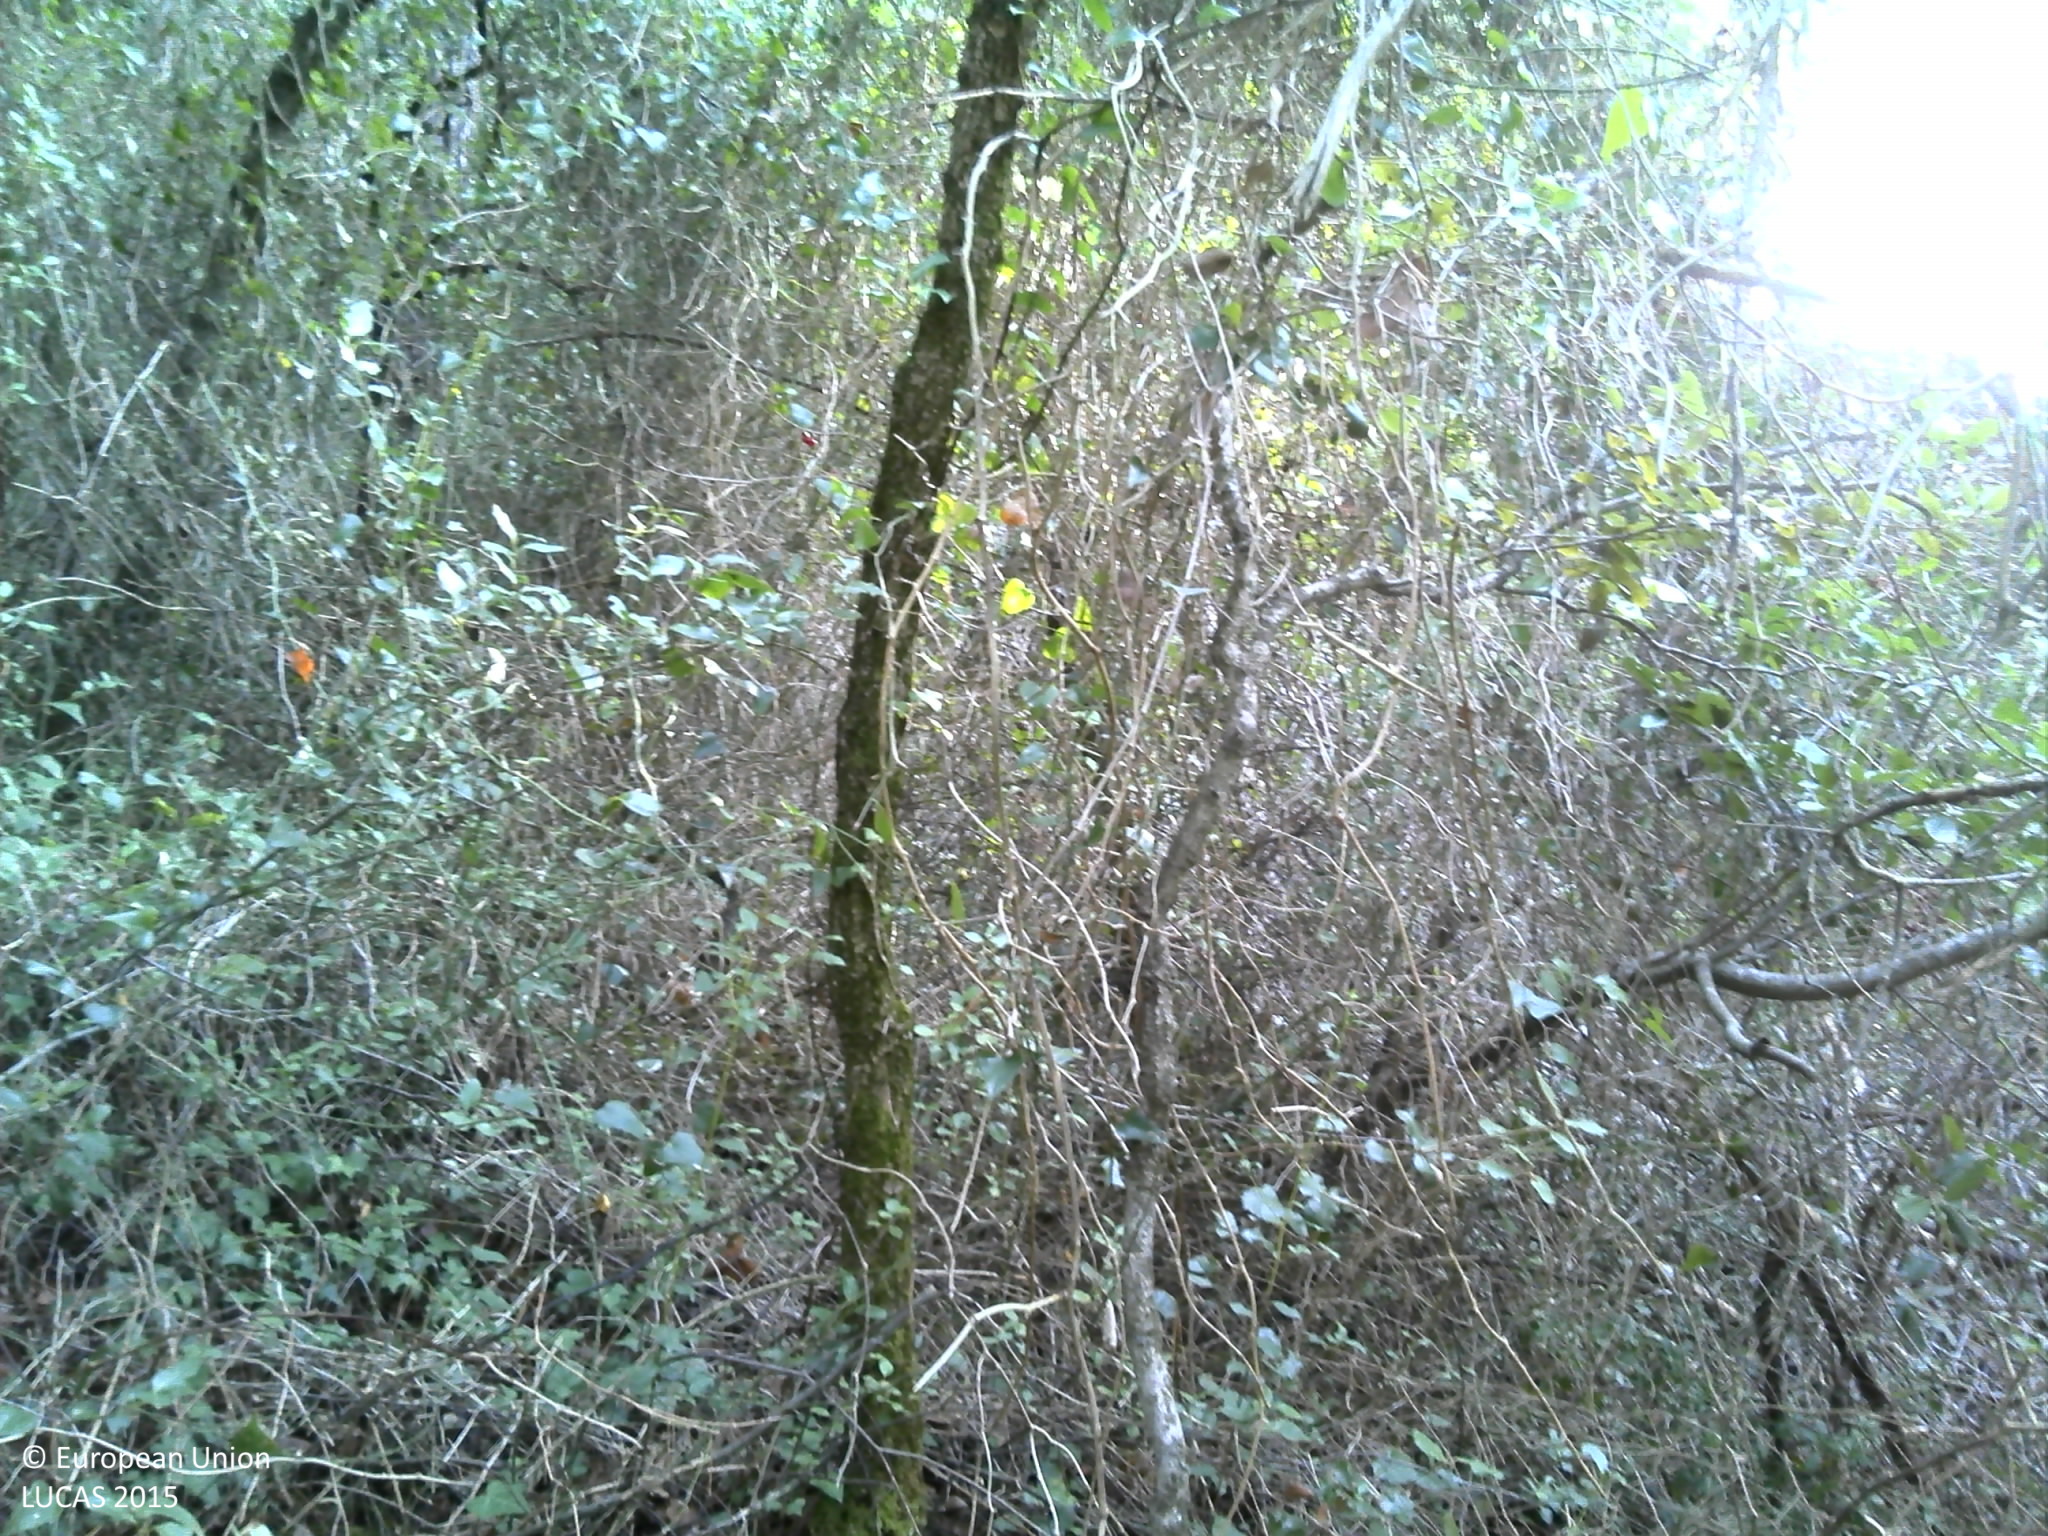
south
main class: Woodland
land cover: Pine dominated mixed woodland
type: broadleaved evergreen forest
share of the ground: > 75 %
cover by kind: broadleaved forest trees 50 %, coniferous forest trees 25 %, herbaceous plants 15 %, lichens and mosses 5 %, unconsolidated bare surface 5 %
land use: Forestry
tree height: > 5 m
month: September
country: FR
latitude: 43.5891
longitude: 6.5526
